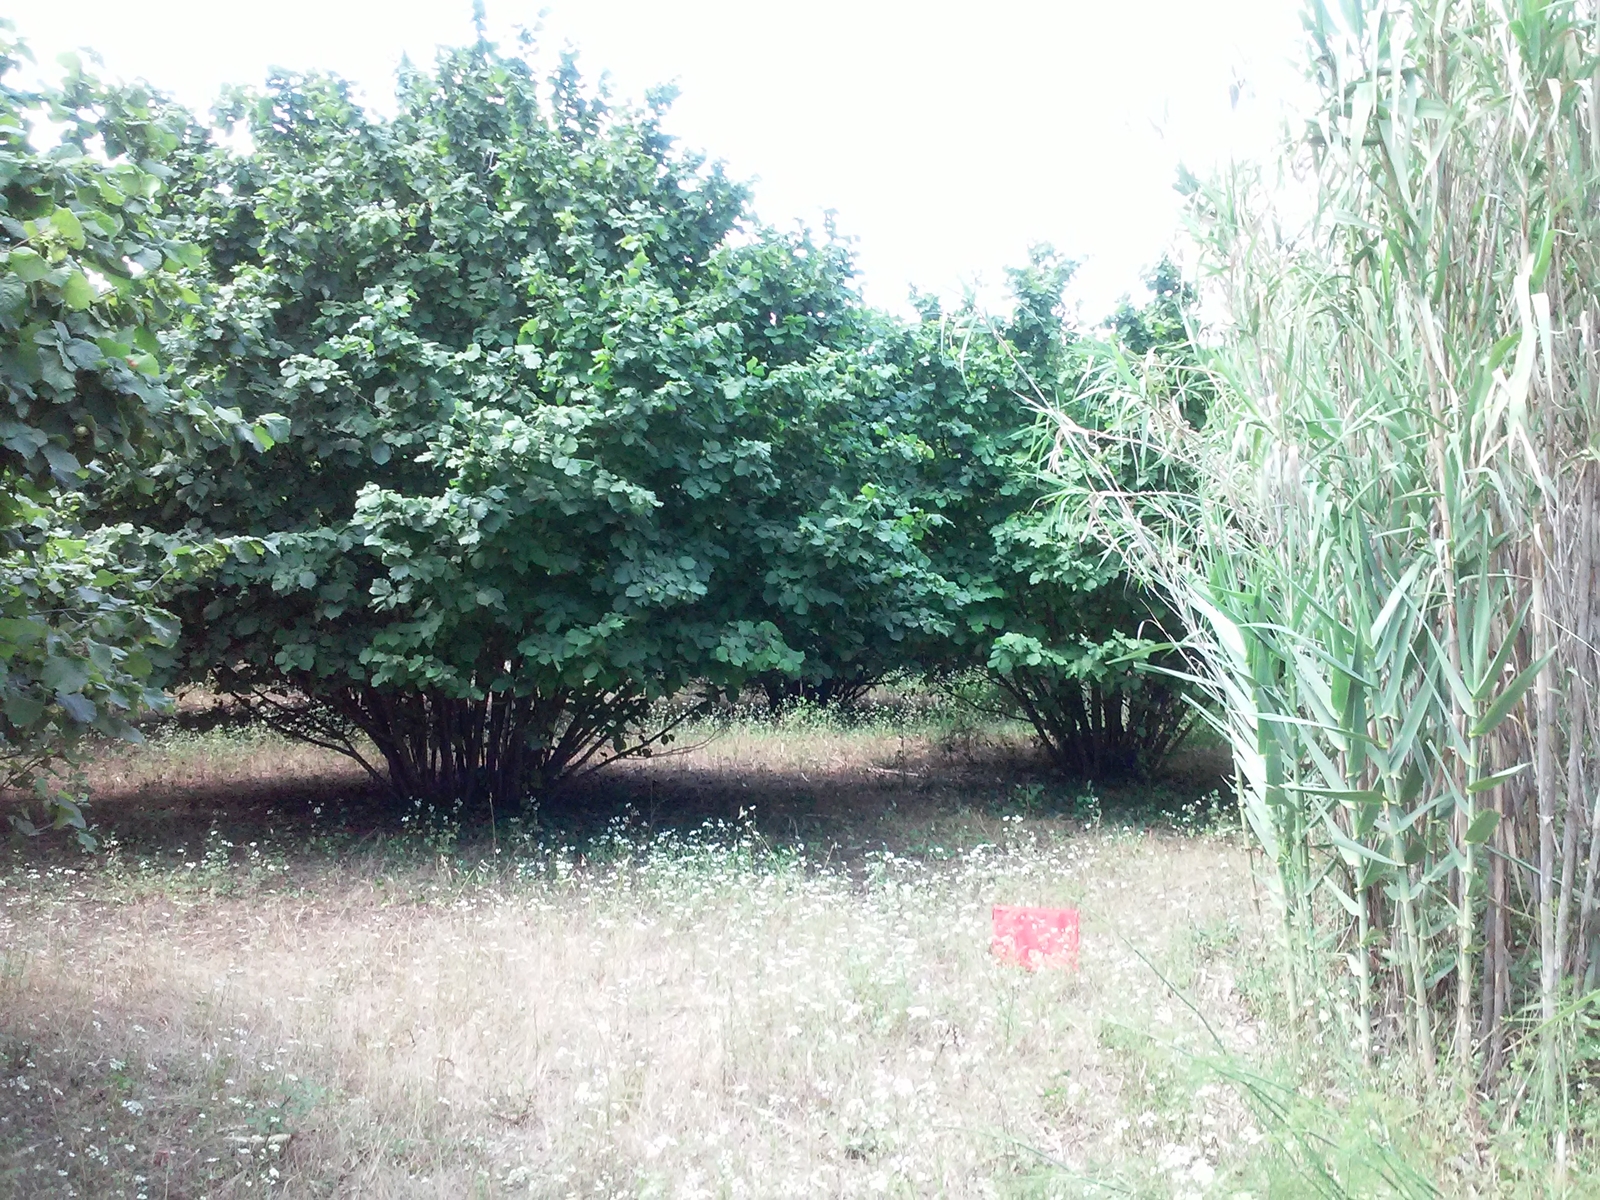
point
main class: Cropland
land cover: Nuts trees
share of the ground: > 75 %
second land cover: Grassland without tree/shrub cover
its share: > 75 %
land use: Agriculture (excluding fallow land and kitchen gardens)
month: June
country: ES
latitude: 41.2750
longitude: 1.2420
